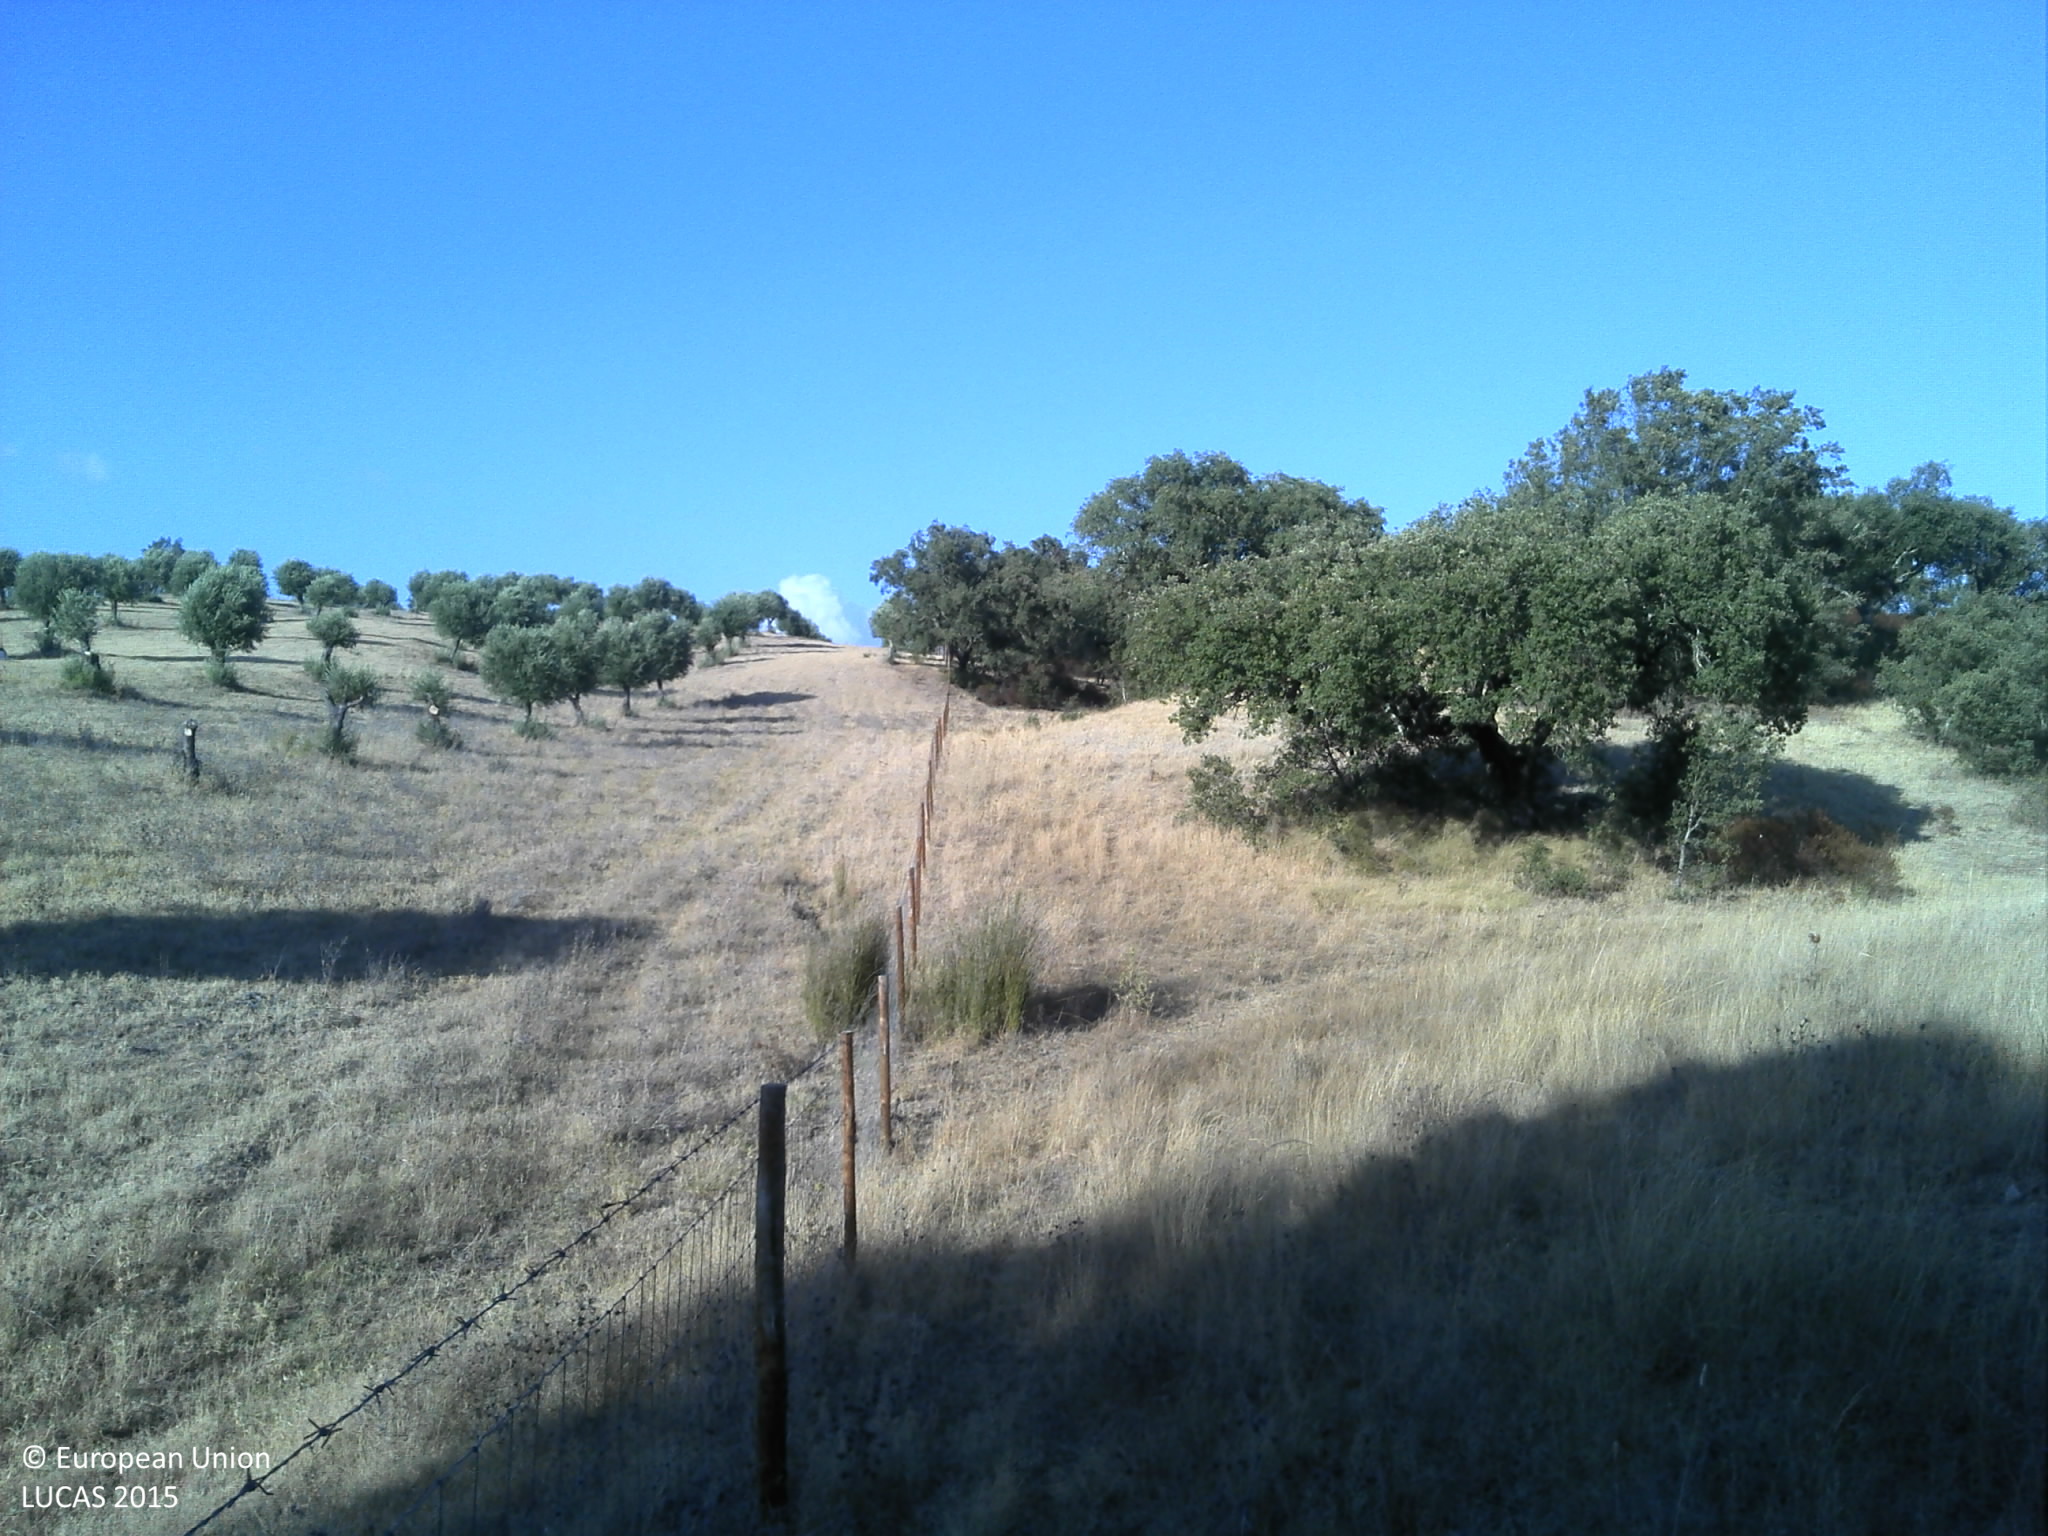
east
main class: Cropland
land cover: Olive groves
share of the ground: 25 - 50 %
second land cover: Grassland without tree/shrub cover
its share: 50 - 75 %
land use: Agriculture (excluding fallow land and kitchen gardens)
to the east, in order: Olive groves; Grassland without tree/shrub cover; Olive groves; Fences; Broadleaved woodland
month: July
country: PT
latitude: 38.8668
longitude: -8.1810
